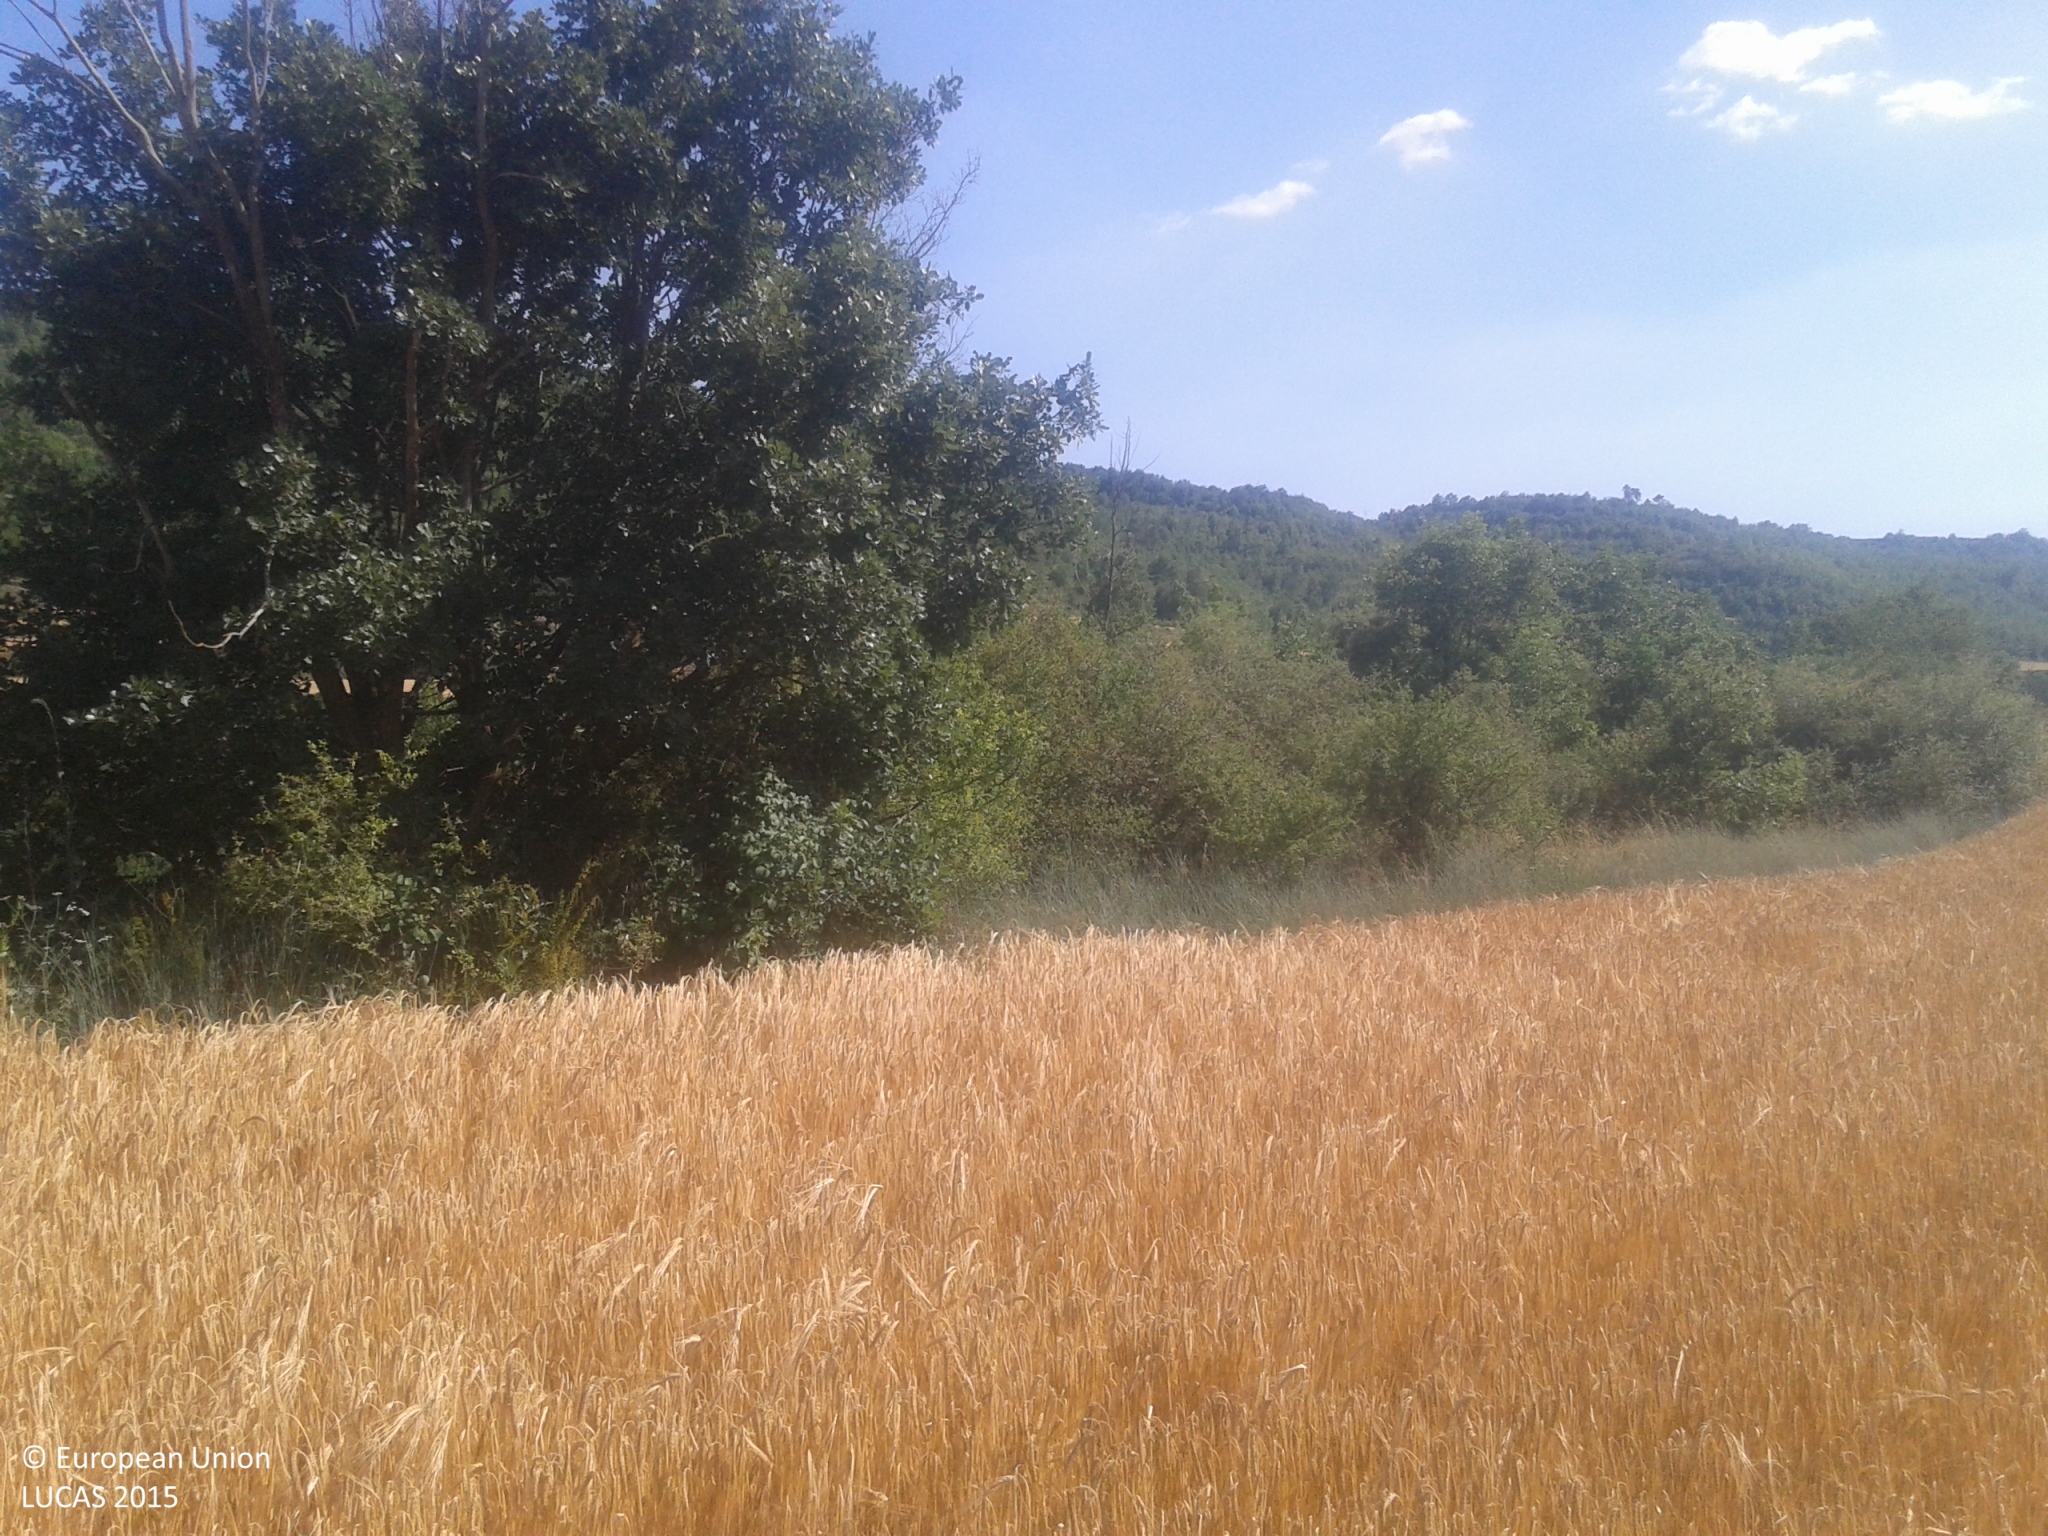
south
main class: Cropland
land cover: Rye
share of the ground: > 75 %
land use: Agriculture (excluding fallow land and kitchen gardens)
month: June
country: ES
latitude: 41.9380
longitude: 1.5582
